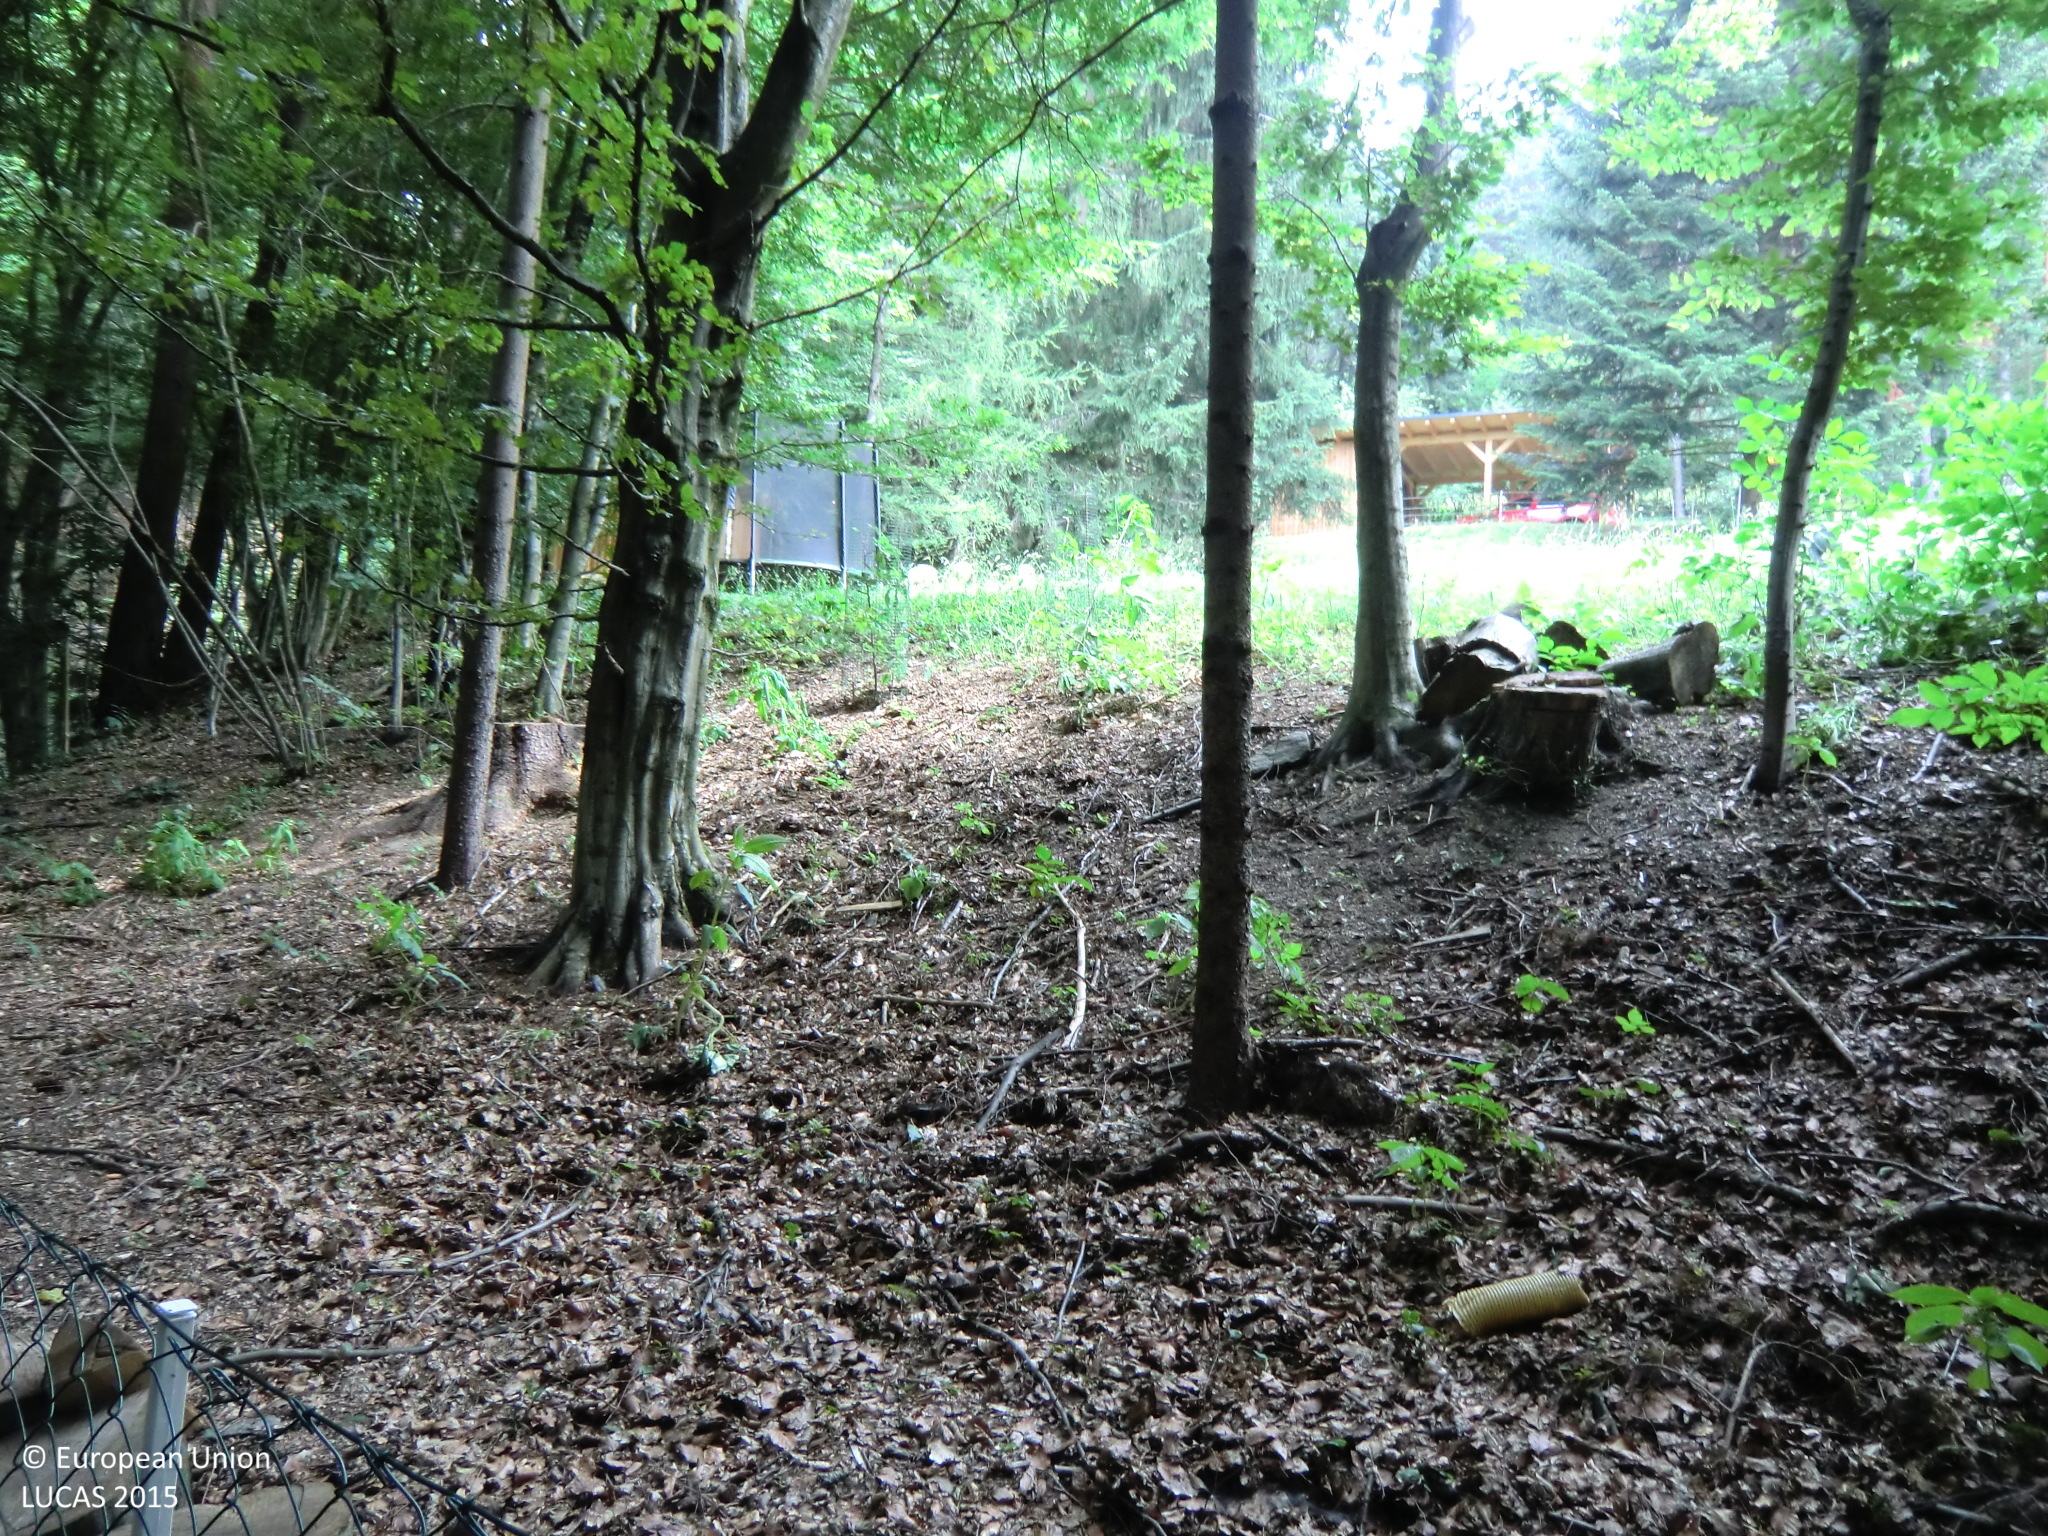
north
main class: Grassland
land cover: Grassland without tree/shrub cover
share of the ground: > 75 %
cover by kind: herbaceous plants 100 %
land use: Residential
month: July
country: AT
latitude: 47.1330
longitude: 15.4449
